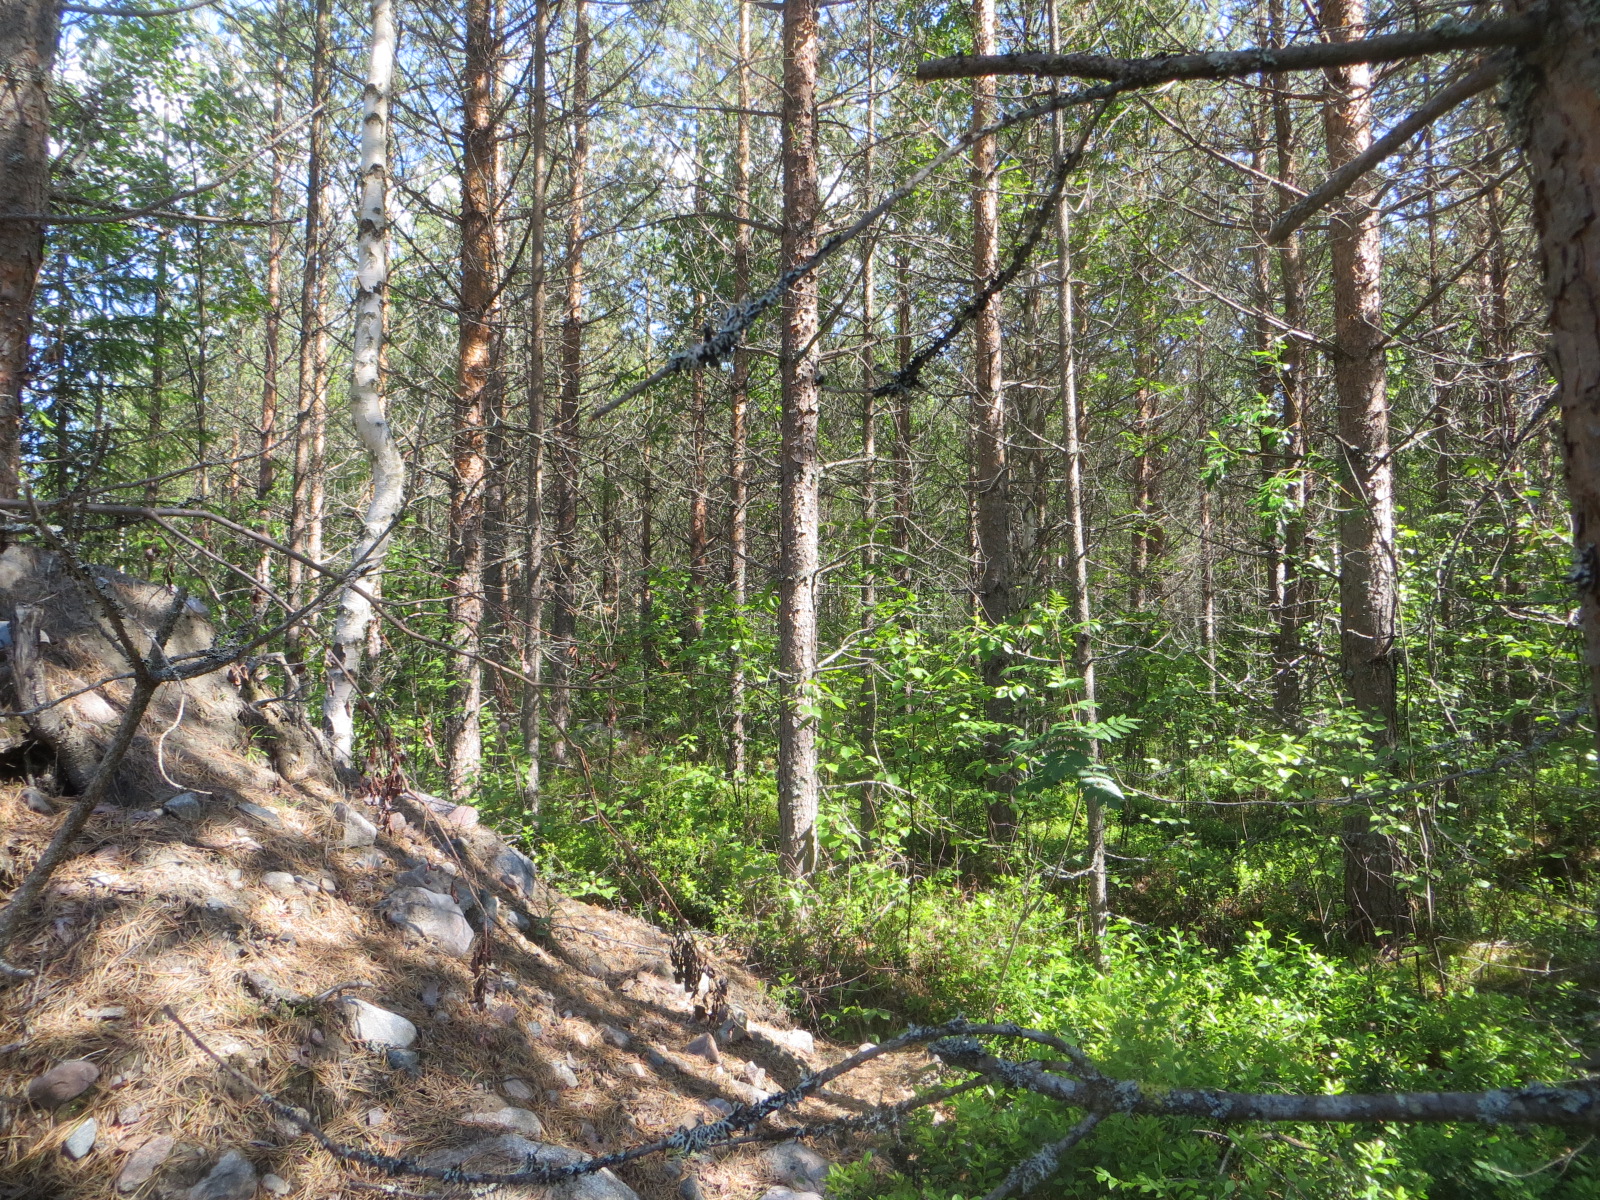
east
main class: Woodland
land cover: Pine dominated mixed woodland
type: boreal forest
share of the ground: > 75 %
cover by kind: coniferous forest trees 55 %, shrubs 25 %, broadleaved forest trees 20 %
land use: Forestry
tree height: > 5 m
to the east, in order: Pine dominated mixed woodland; Ditches and canals; Pine dominated mixed woodland; Ditches and canals; Pine dominated mixed woodland; Ditches and canals; Other mixed woodland; Ditches and canals; Other mixed woodland; Ditches and canals; Other mixed woodland; Ditches and canals; Other mixed woodland; Ditches and canals; Other mixed woodland
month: July
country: FI
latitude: 65.3847
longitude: 25.3304
